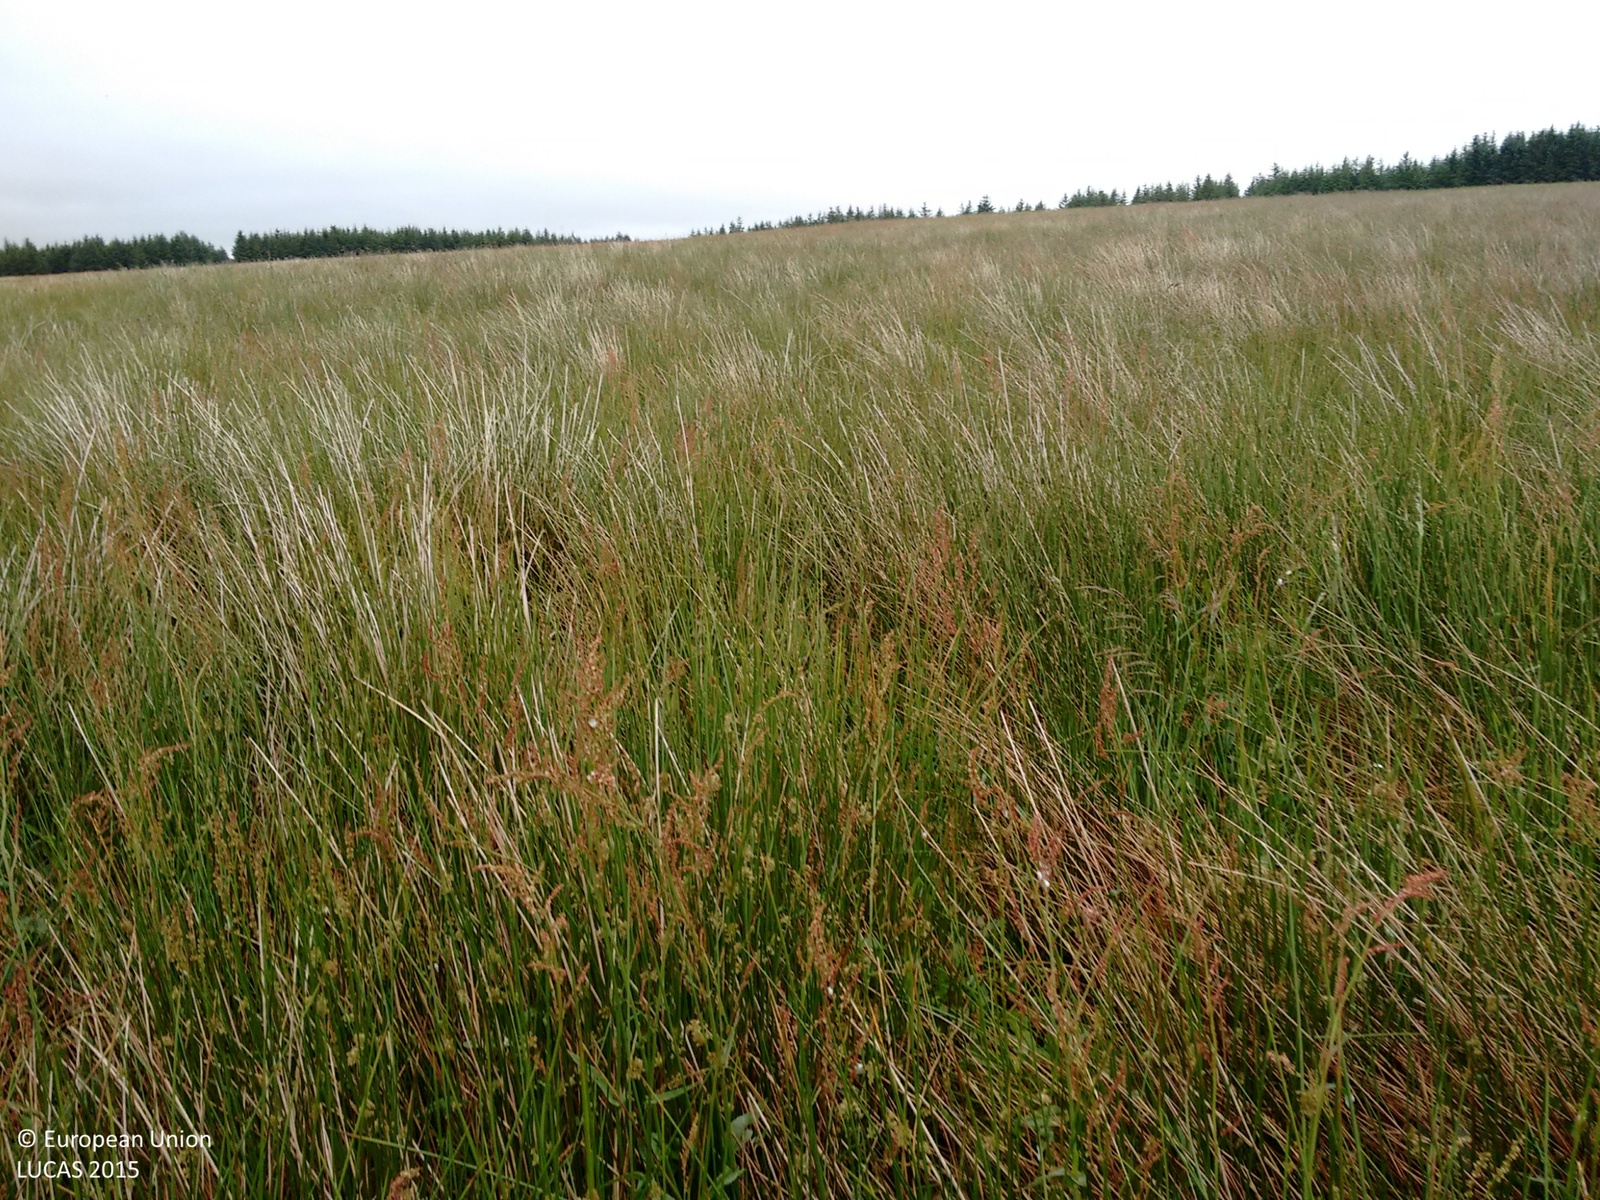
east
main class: Grassland
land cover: Grassland without tree/shrub cover
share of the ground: > 75 %
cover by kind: herbaceous plants 70 %, lichens and mosses 30 %
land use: Agriculture (excluding fallow land and kitchen gardens)
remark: Temporary flooded
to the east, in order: Grassland without tree/shrub cover
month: July
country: GB
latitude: 55.6427
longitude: -4.2505
